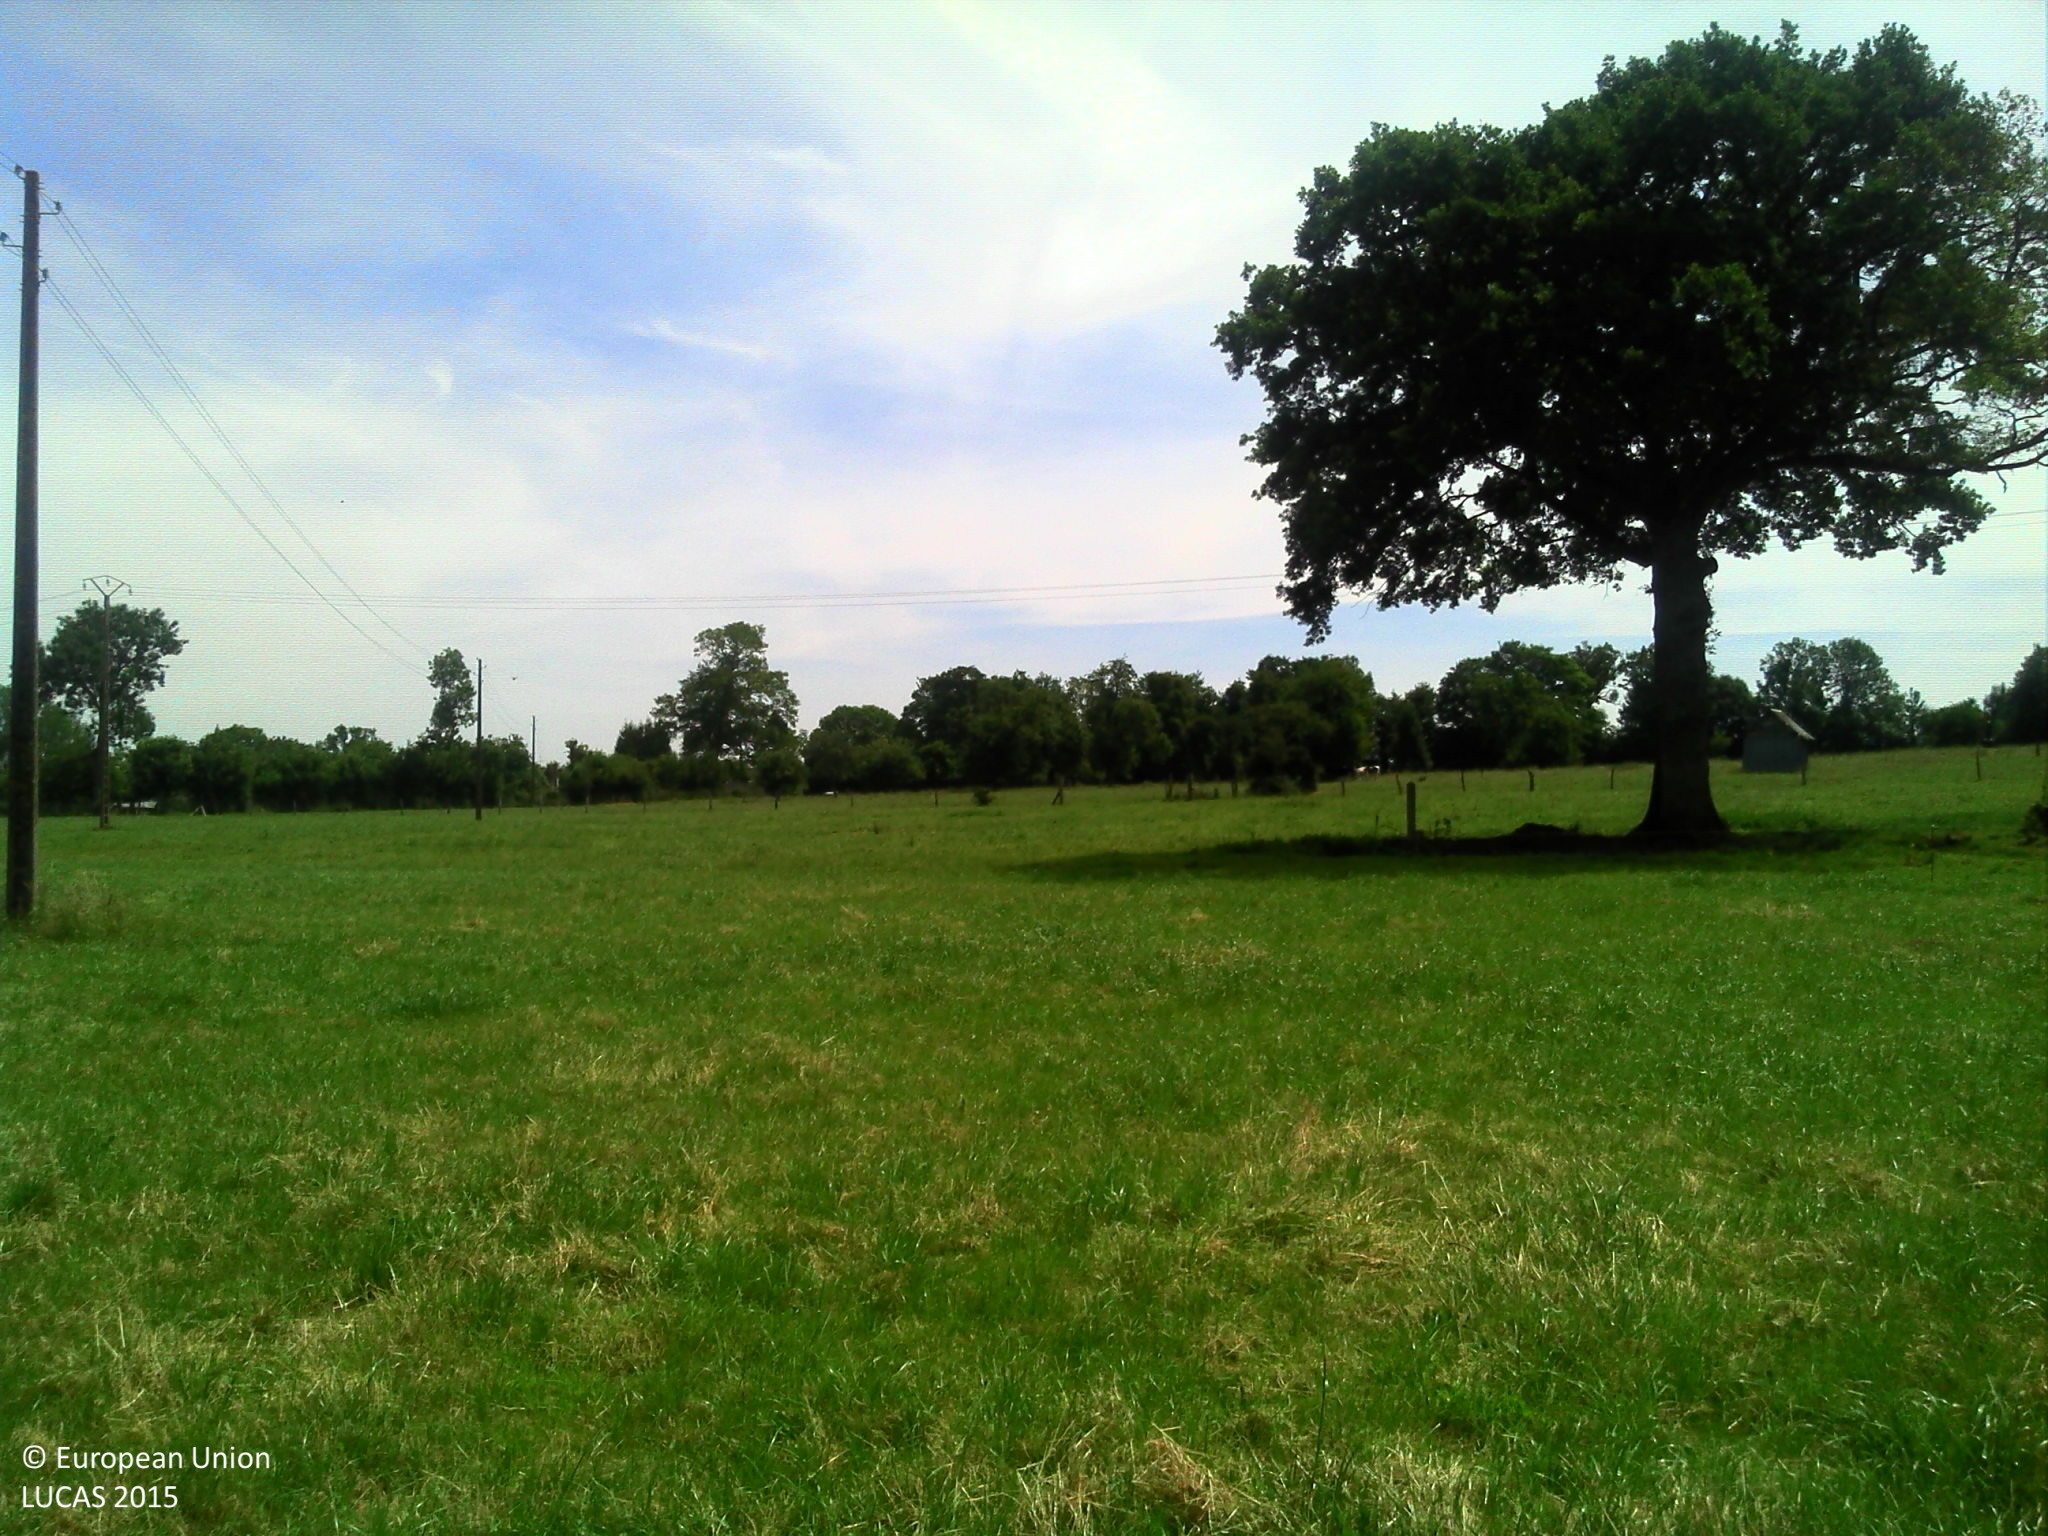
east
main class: Grassland
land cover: Grassland without tree/shrub cover
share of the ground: > 75 %
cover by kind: herbaceous plants 100 %
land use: Agriculture (excluding fallow land and kitchen gardens)
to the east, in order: Grassland without tree/shrub cover; Fences; Grassland without tree/shrub cover; Electric lines; Grassland without tree/shrub cover; Fences; Grassland without tree/shrub cover; Fences; Grassland with sparse tree/shrub cover
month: June
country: FR
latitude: 48.7958
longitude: -0.2564
